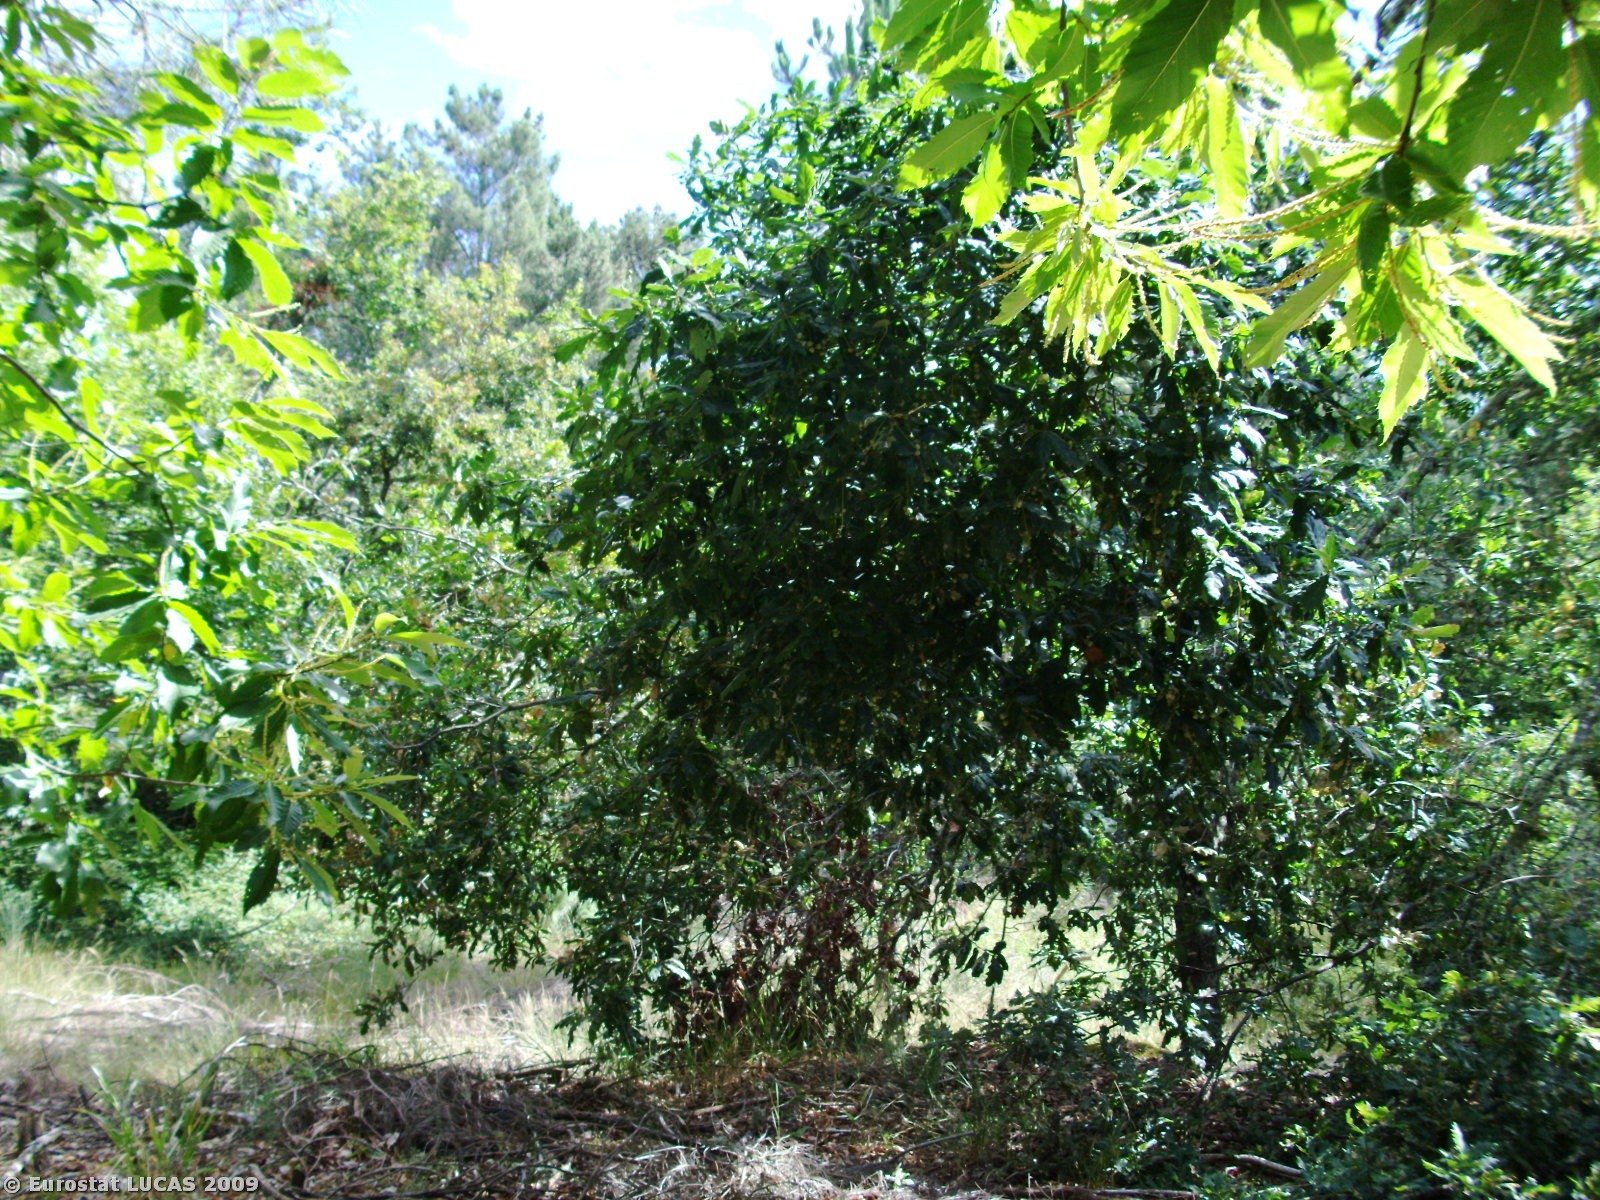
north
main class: Woodland
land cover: Broadleaved woodland
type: thermophilous deciduous forest
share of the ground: > 75 %
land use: Forestry
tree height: > 5 m
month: July
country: PT
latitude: 40.8212
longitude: -7.7048
